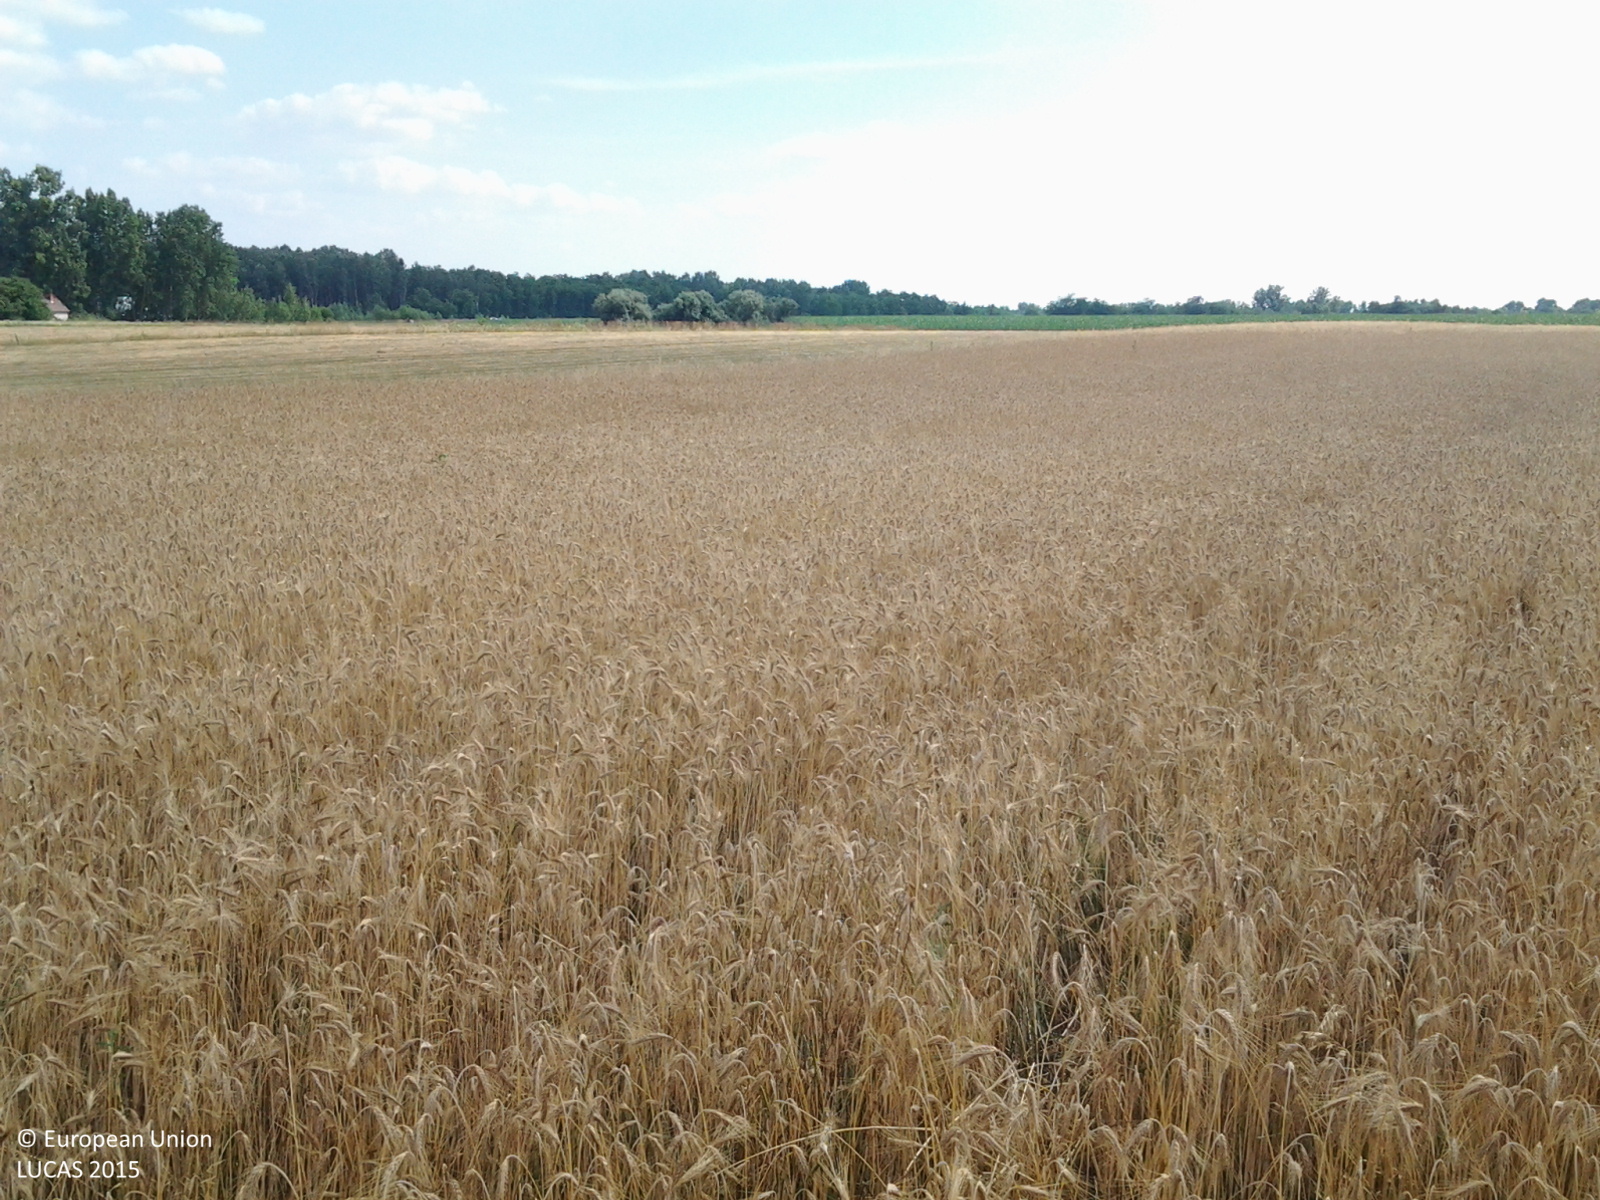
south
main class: Cropland
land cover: Triticale
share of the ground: > 75 %
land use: Agriculture (excluding fallow land and kitchen gardens)
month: July
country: HU
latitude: 47.4572
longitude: 19.8266
